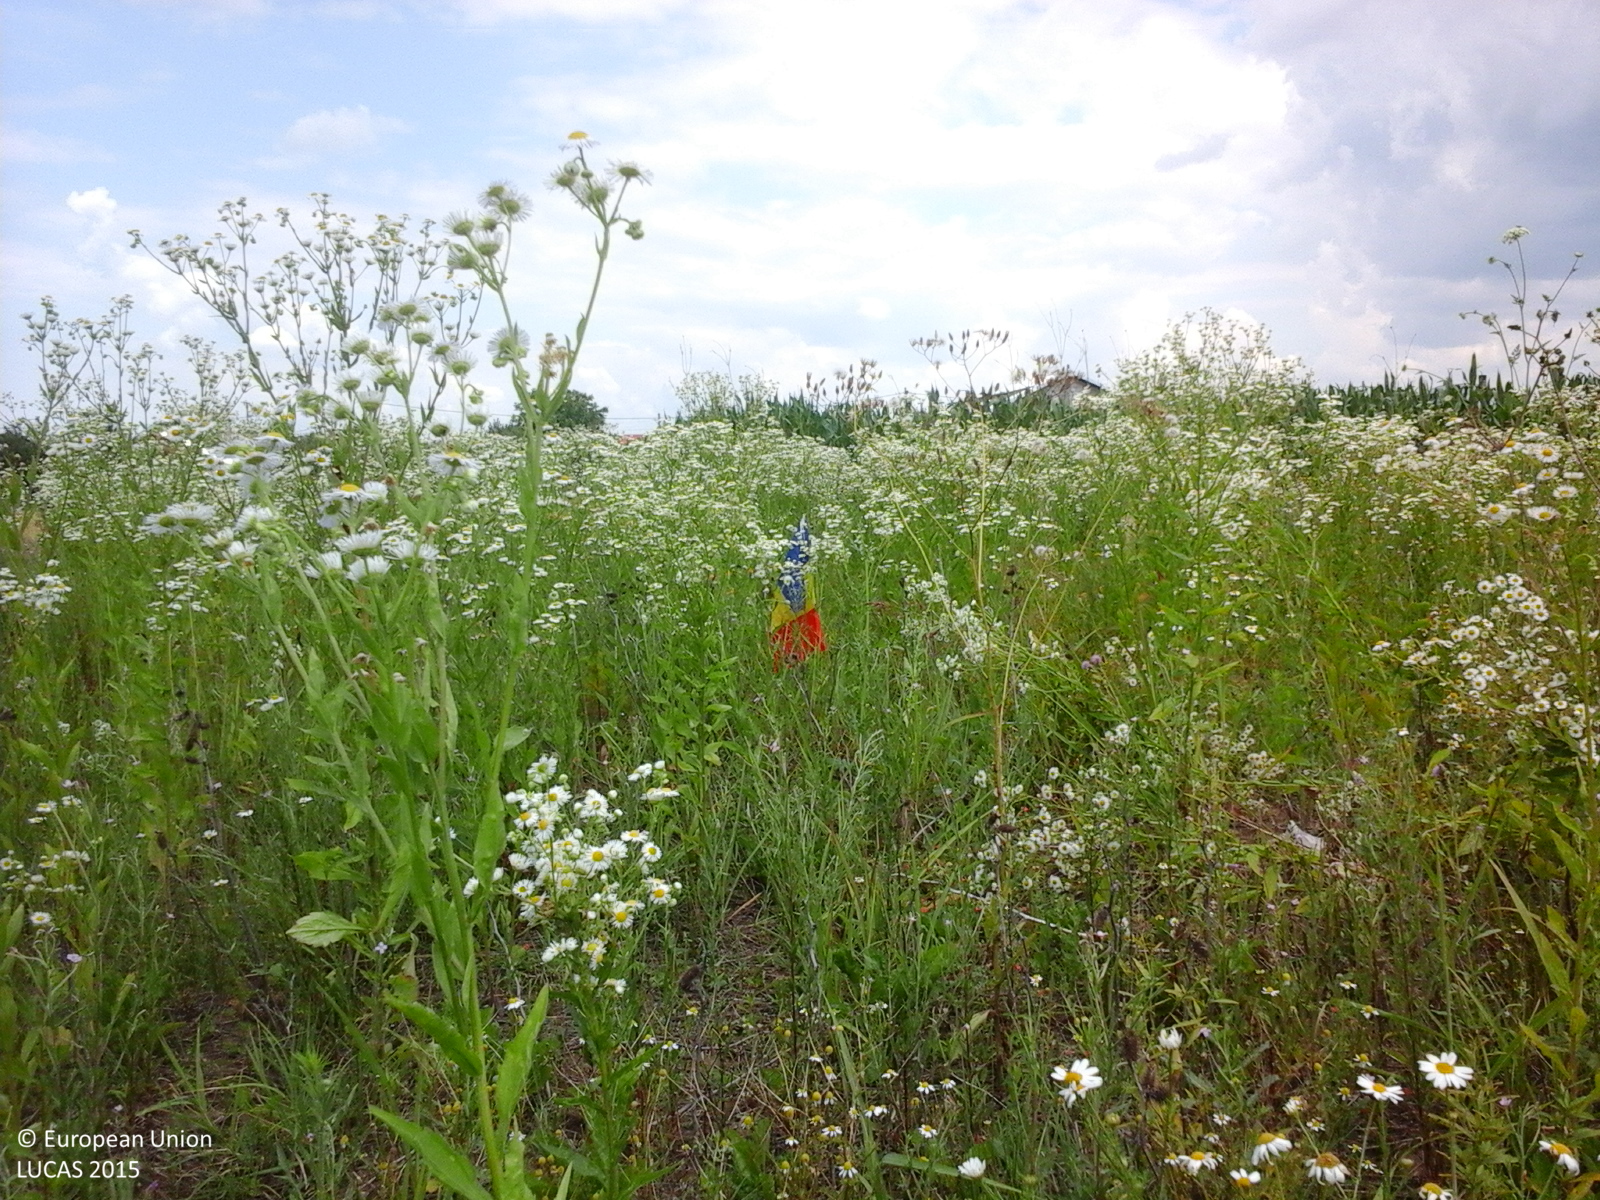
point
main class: Grassland
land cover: Spontaneously vegetated surfaces
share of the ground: > 75 %
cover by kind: herbaceous plants 100 %
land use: Agriculture (excluding fallow land and kitchen gardens)
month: June
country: RO
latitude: 44.6412
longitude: 26.2354
